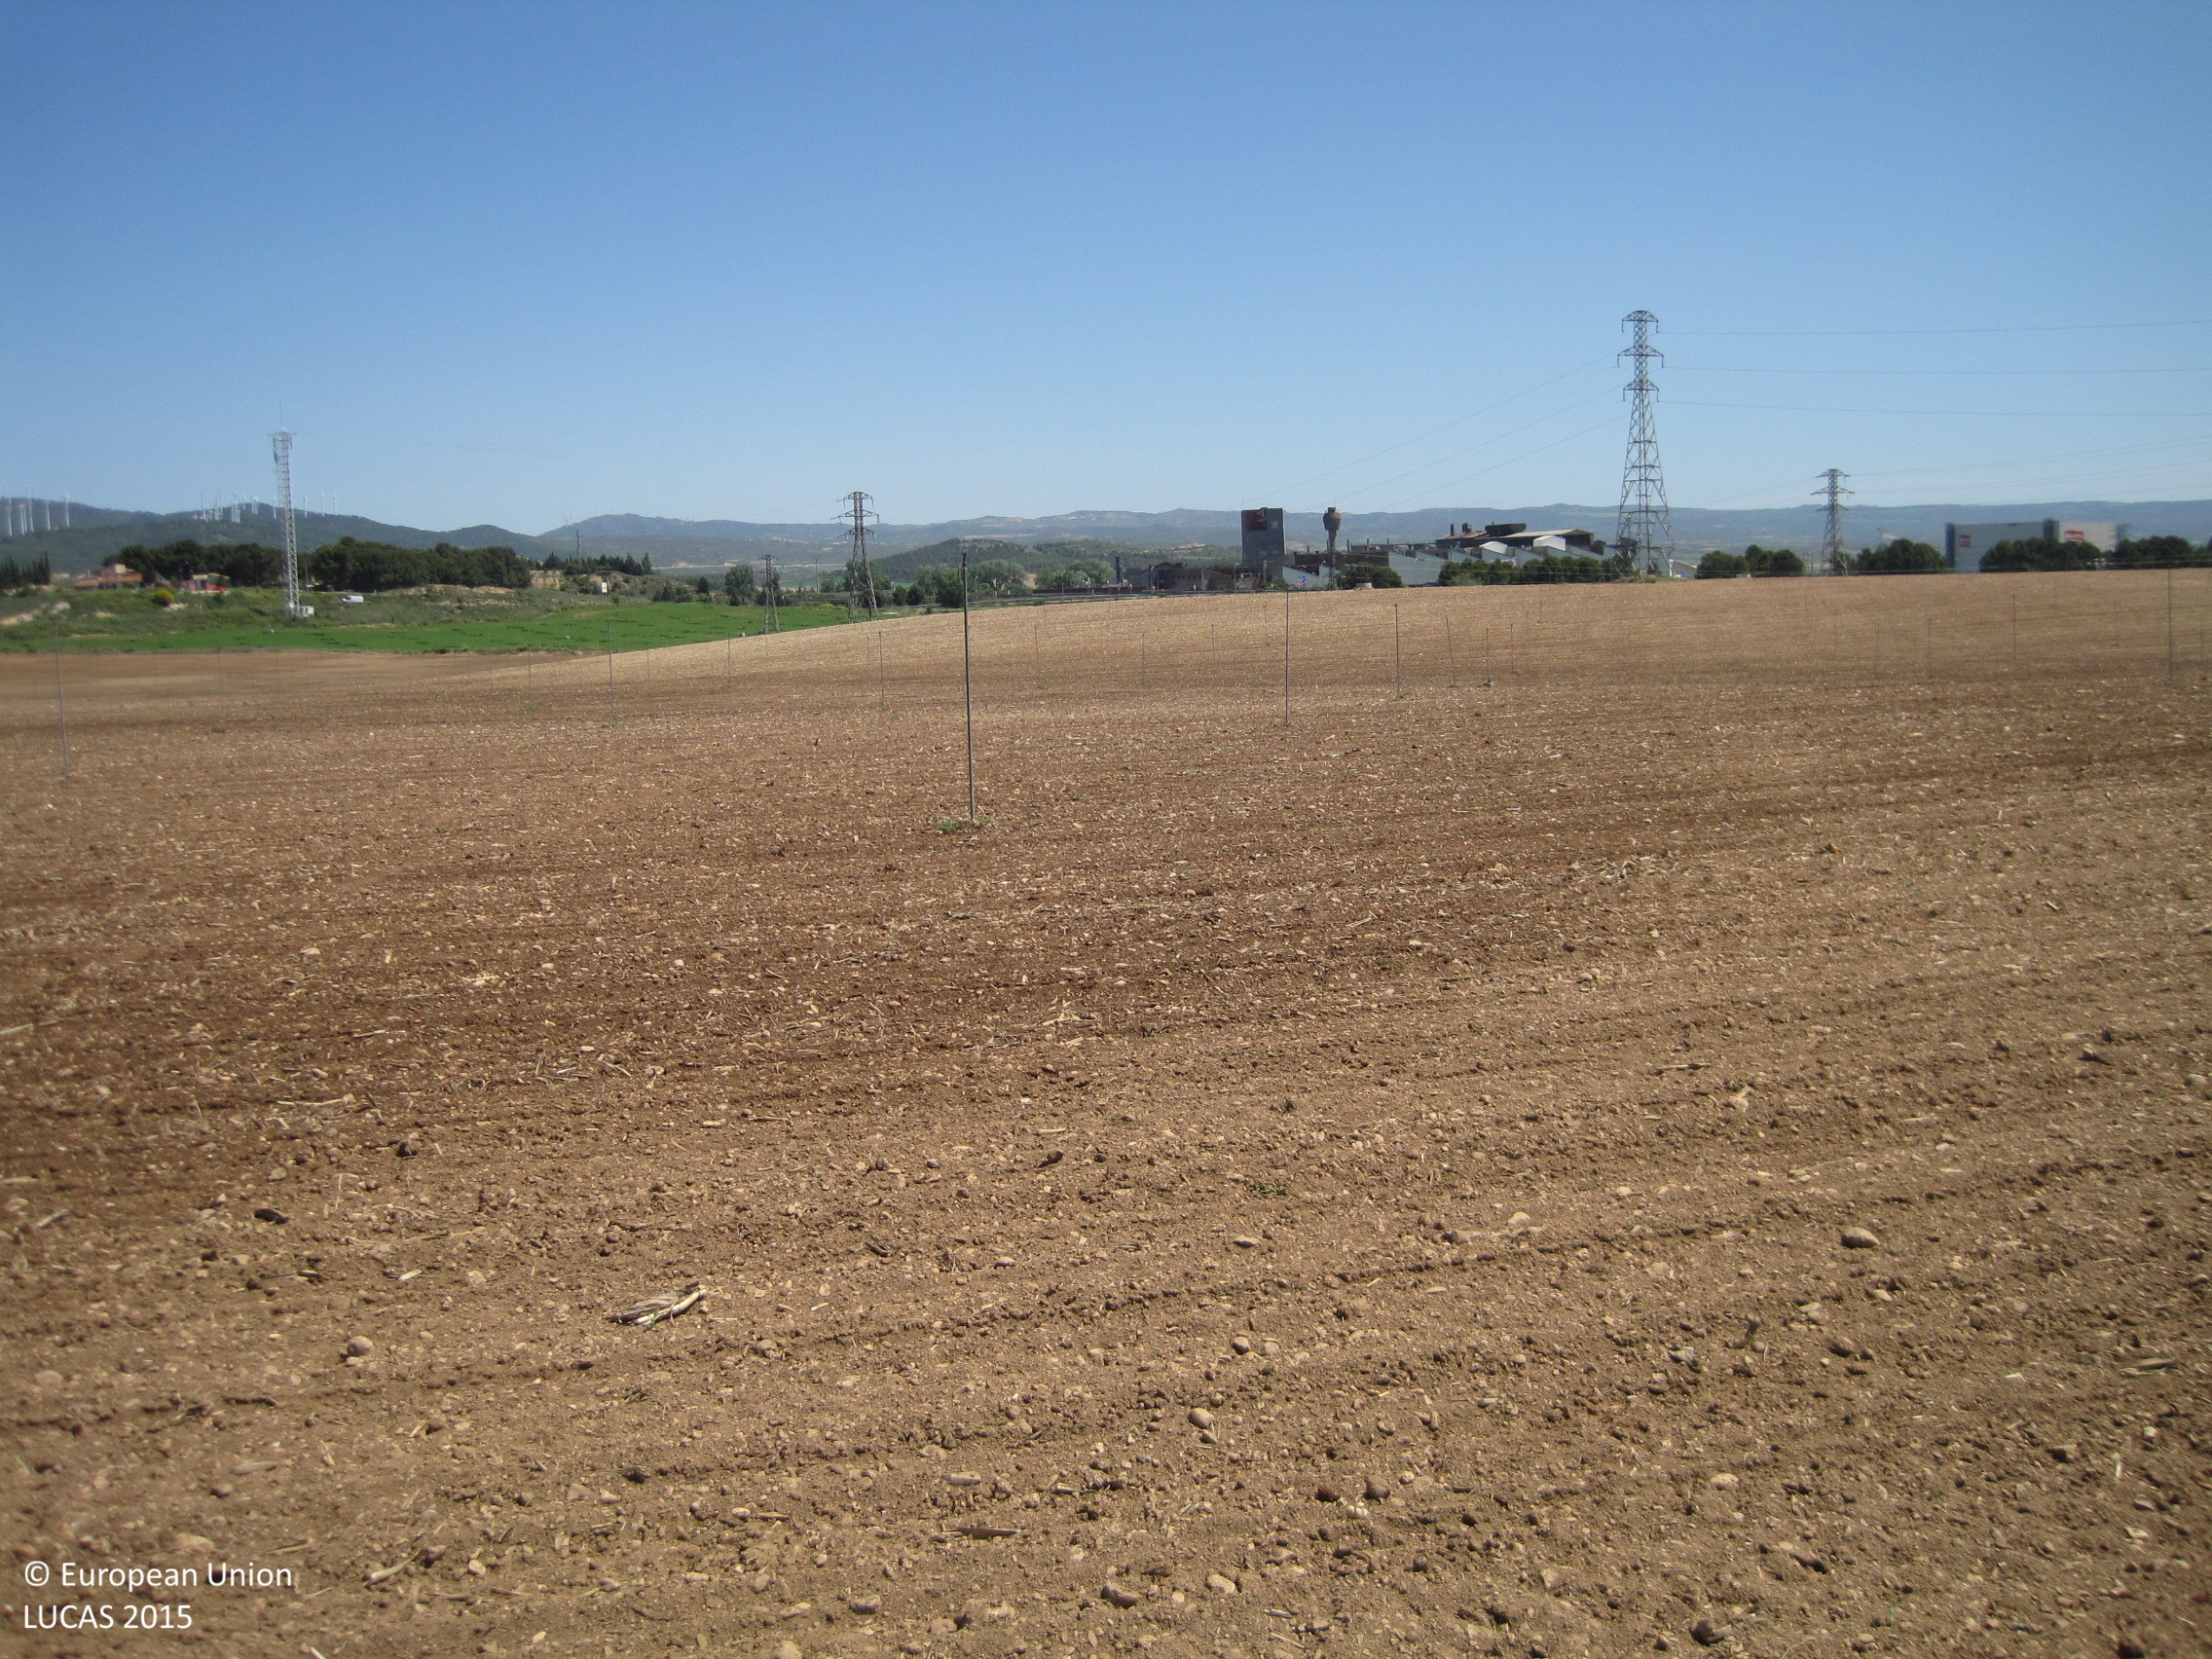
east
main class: Cropland
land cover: Maize
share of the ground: < 10 %
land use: Agriculture (excluding fallow land and kitchen gardens)
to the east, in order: Maize; Electric lines; Maize
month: May
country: ES
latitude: 42.5041
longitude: -1.6827
